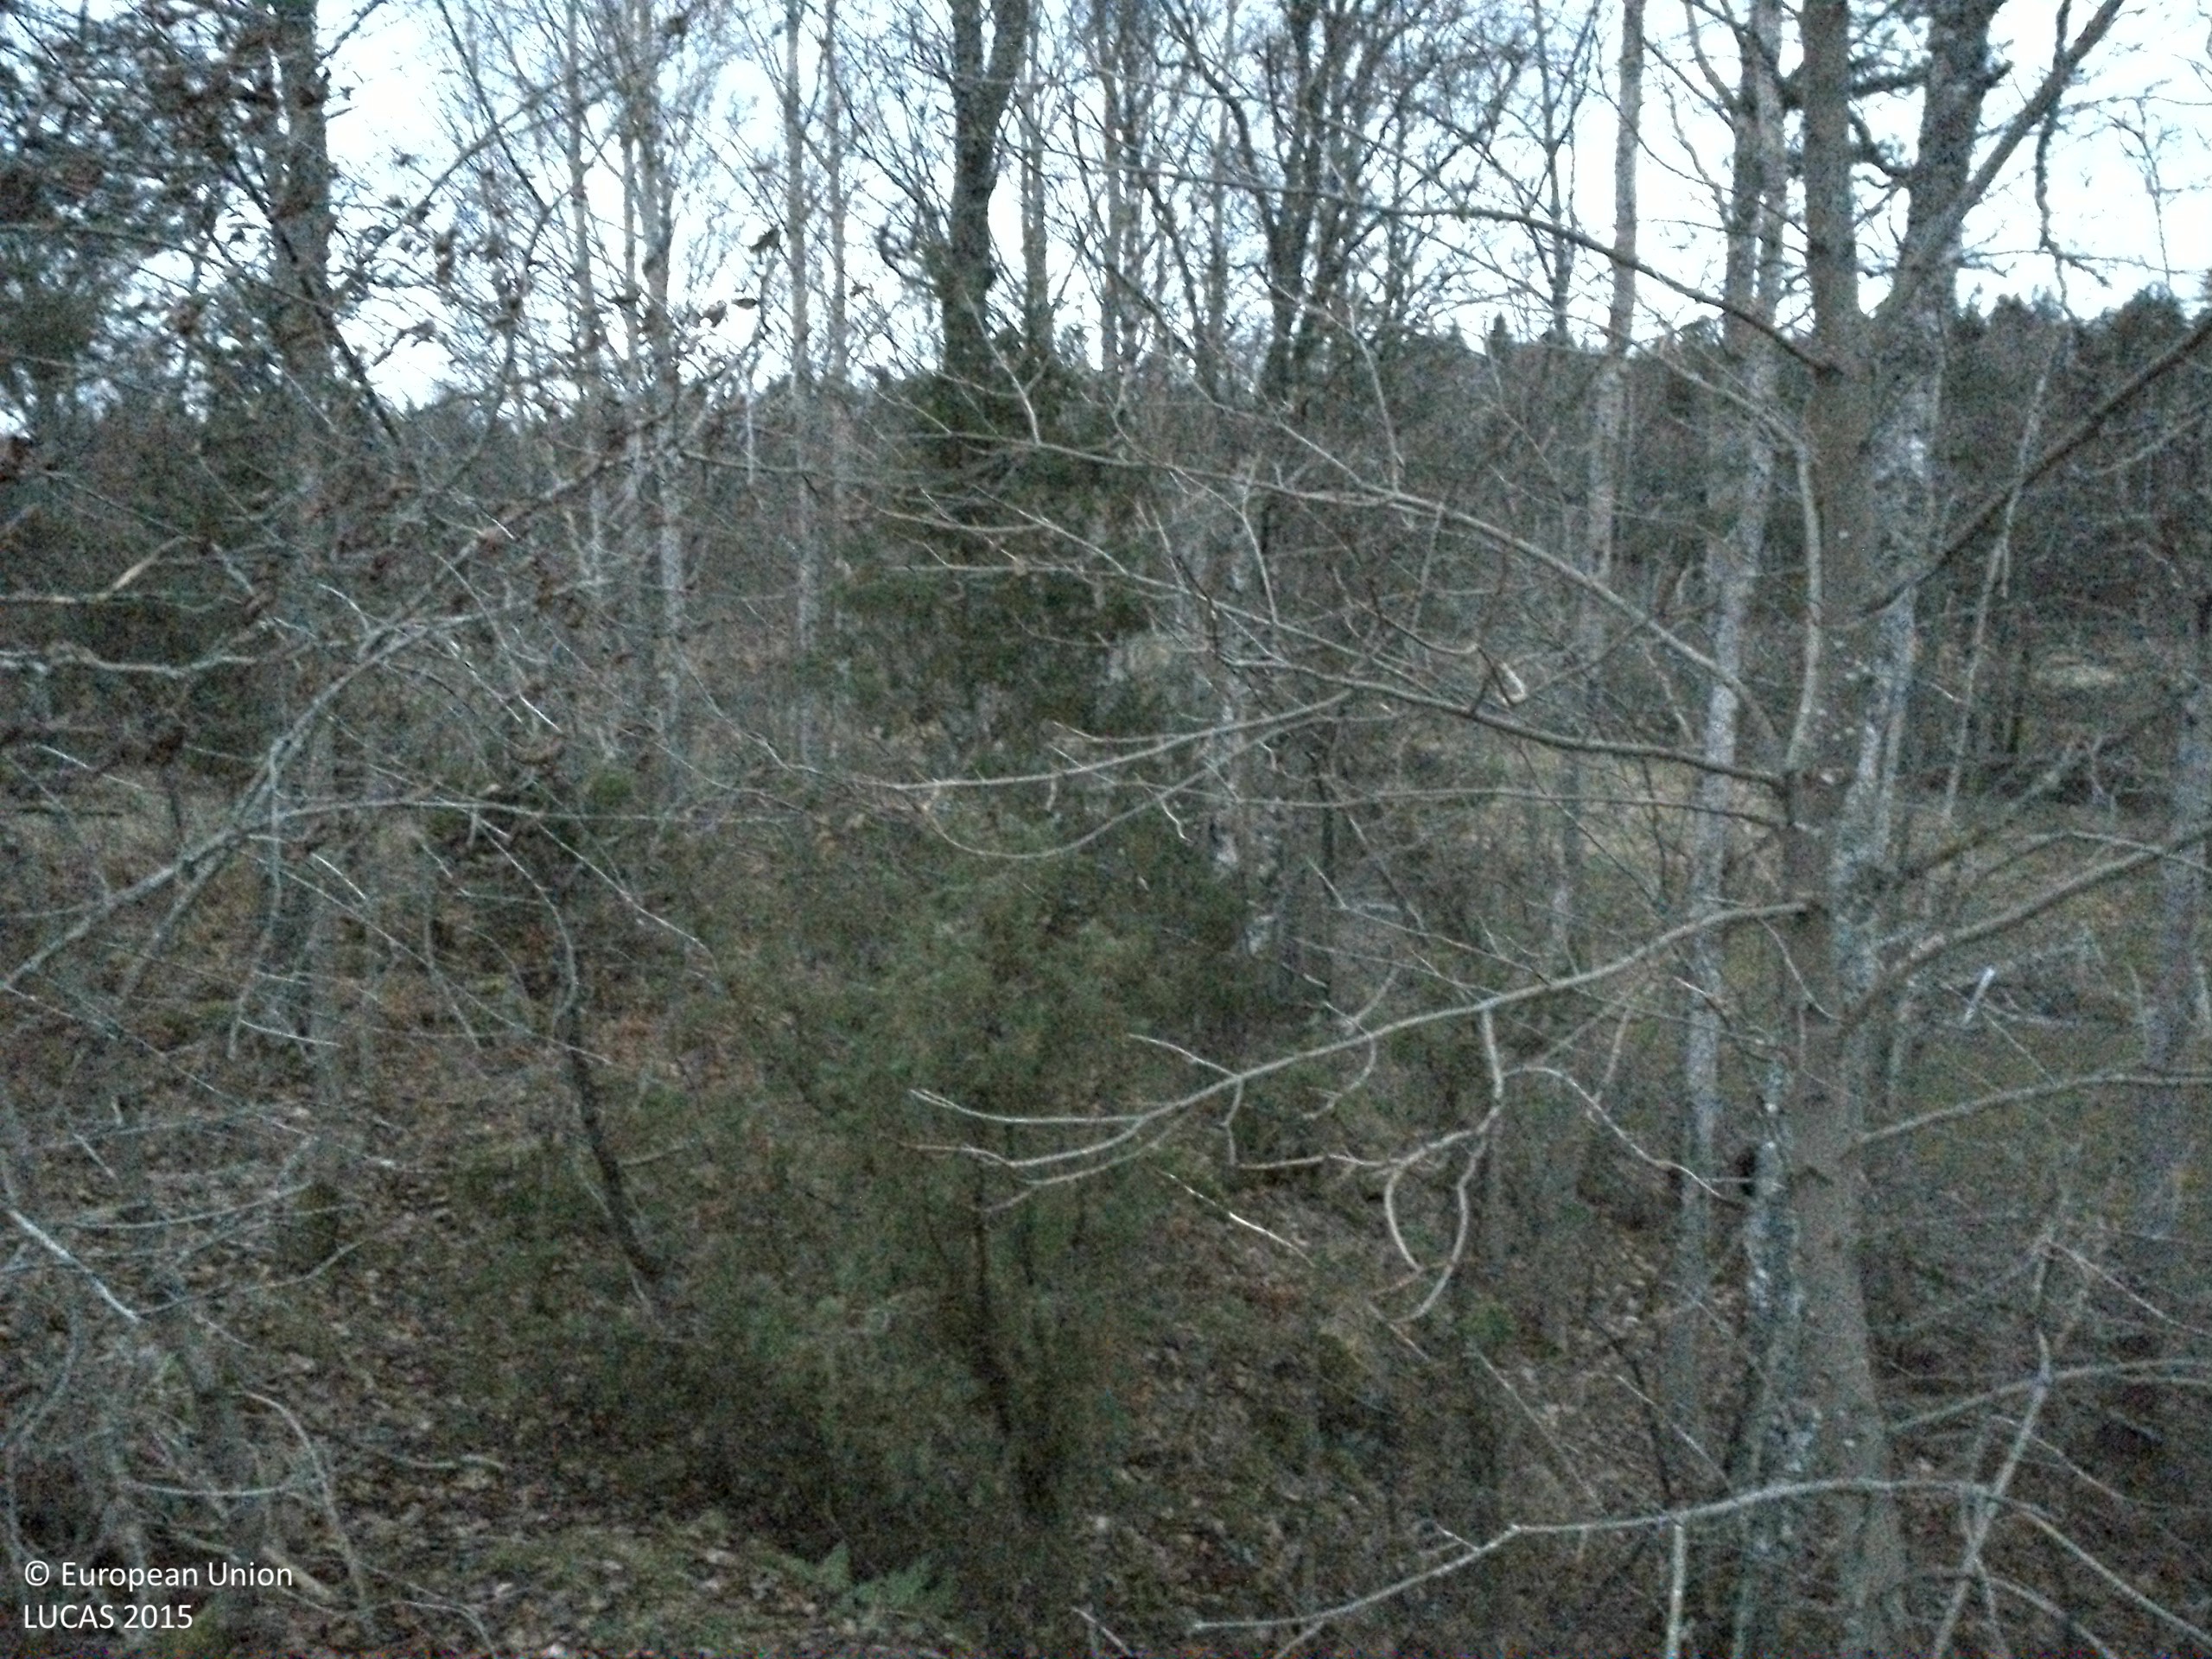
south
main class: Woodland
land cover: Broadleaved woodland
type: boreal forest
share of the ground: 25 - 50 %
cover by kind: consolidated bare surface 40 %, broadleaved forest trees 35 %, coniferous forest trees 10 %, lichens and mosses 10 %, herbaceous plants 5 %
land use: Semi-natural and natural areas not in use
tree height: > 5 m
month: December
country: SE
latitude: 59.2249
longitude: 17.0915
